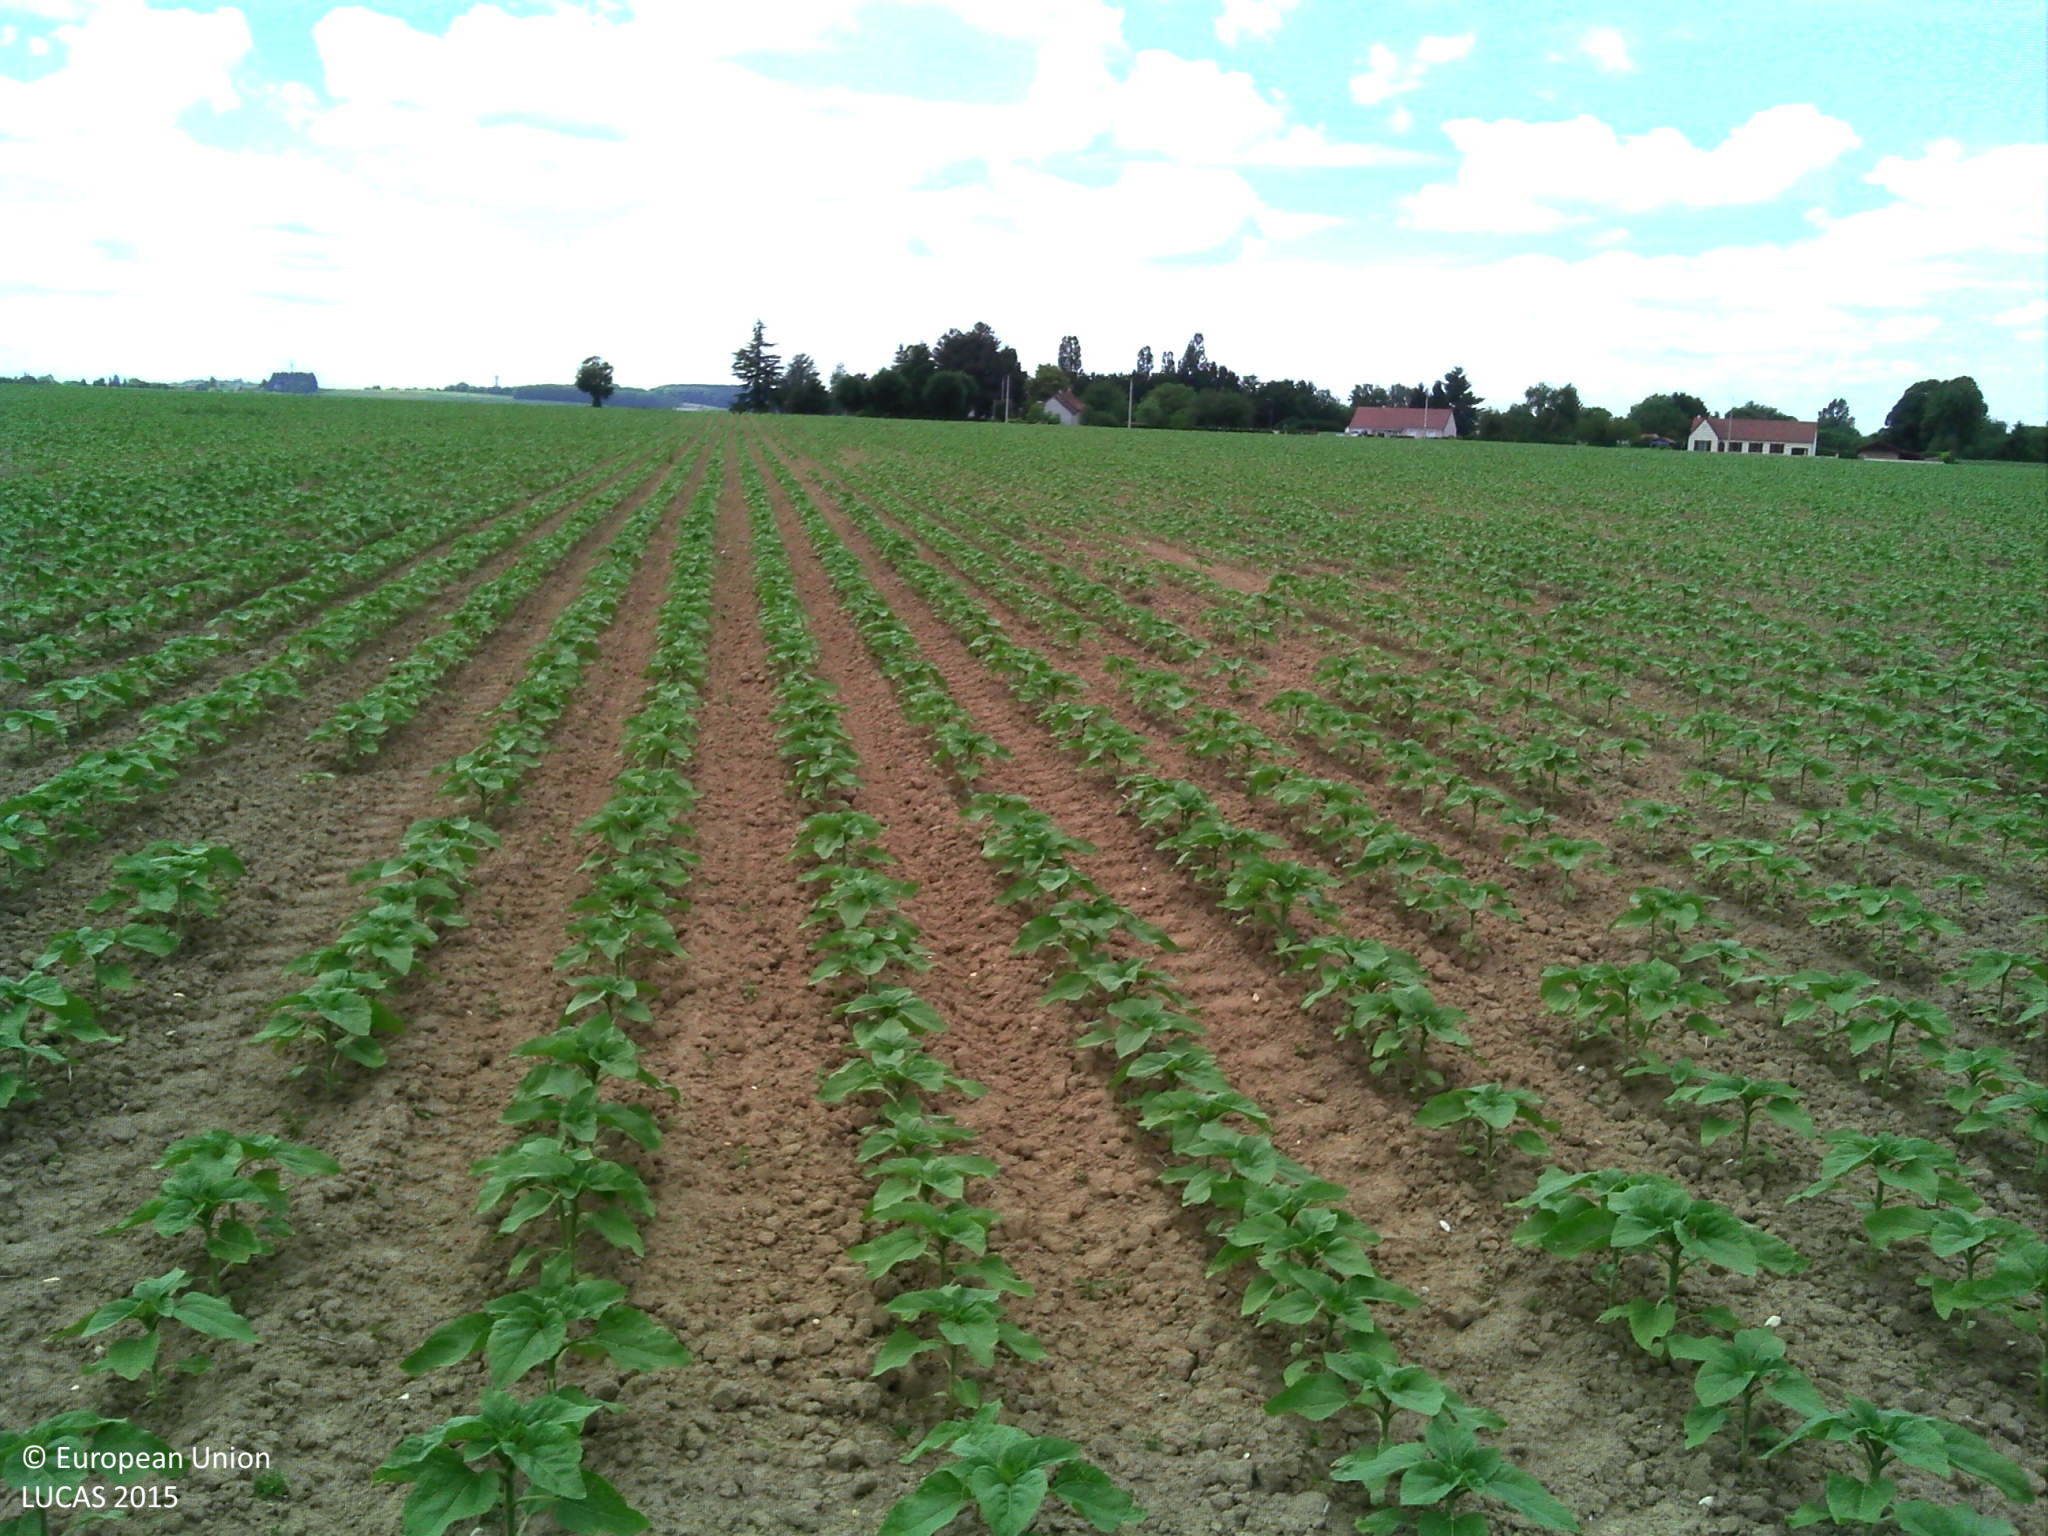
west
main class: Cropland
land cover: Sunflower
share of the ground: 25 - 50 %
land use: Agriculture (excluding fallow land and kitchen gardens)
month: May
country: FR
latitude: 47.1659
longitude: 2.9372
